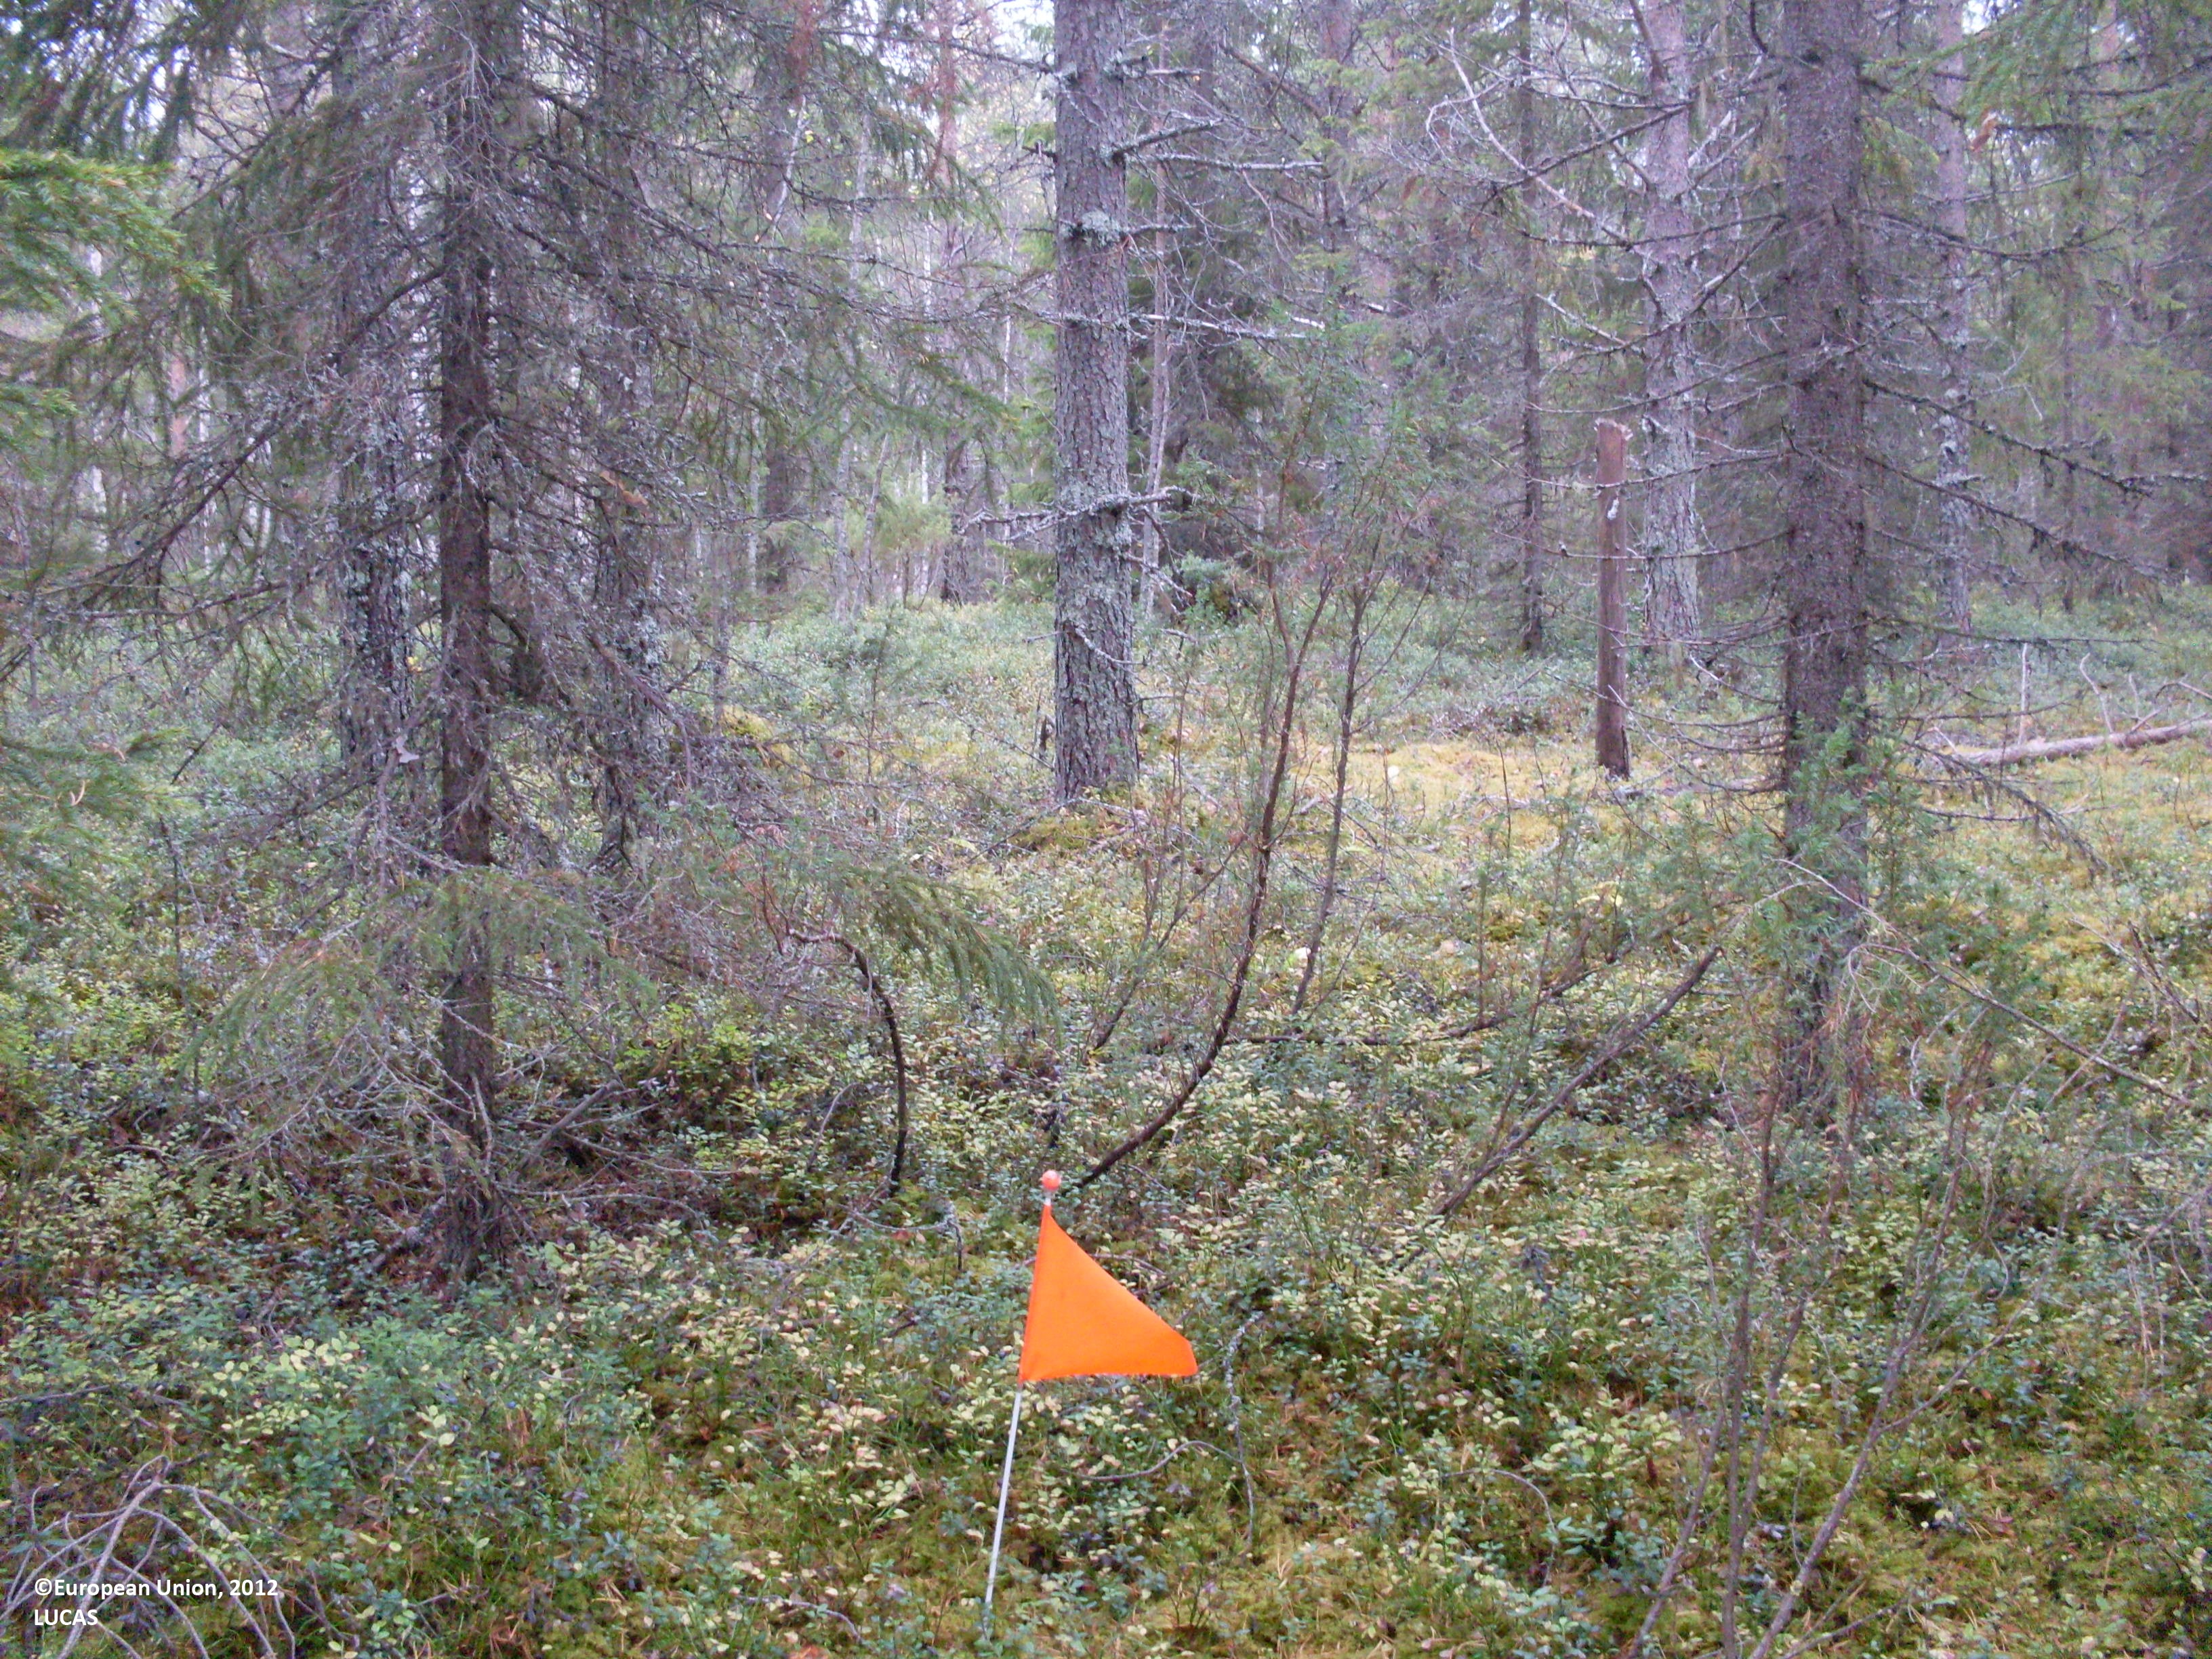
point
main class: Woodland
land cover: Spruce dominated coniferous woodland
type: boreal forest
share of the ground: 50 - 75 %
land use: Forestry
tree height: > 5 m
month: September
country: FI
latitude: 64.4364
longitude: 28.4747
